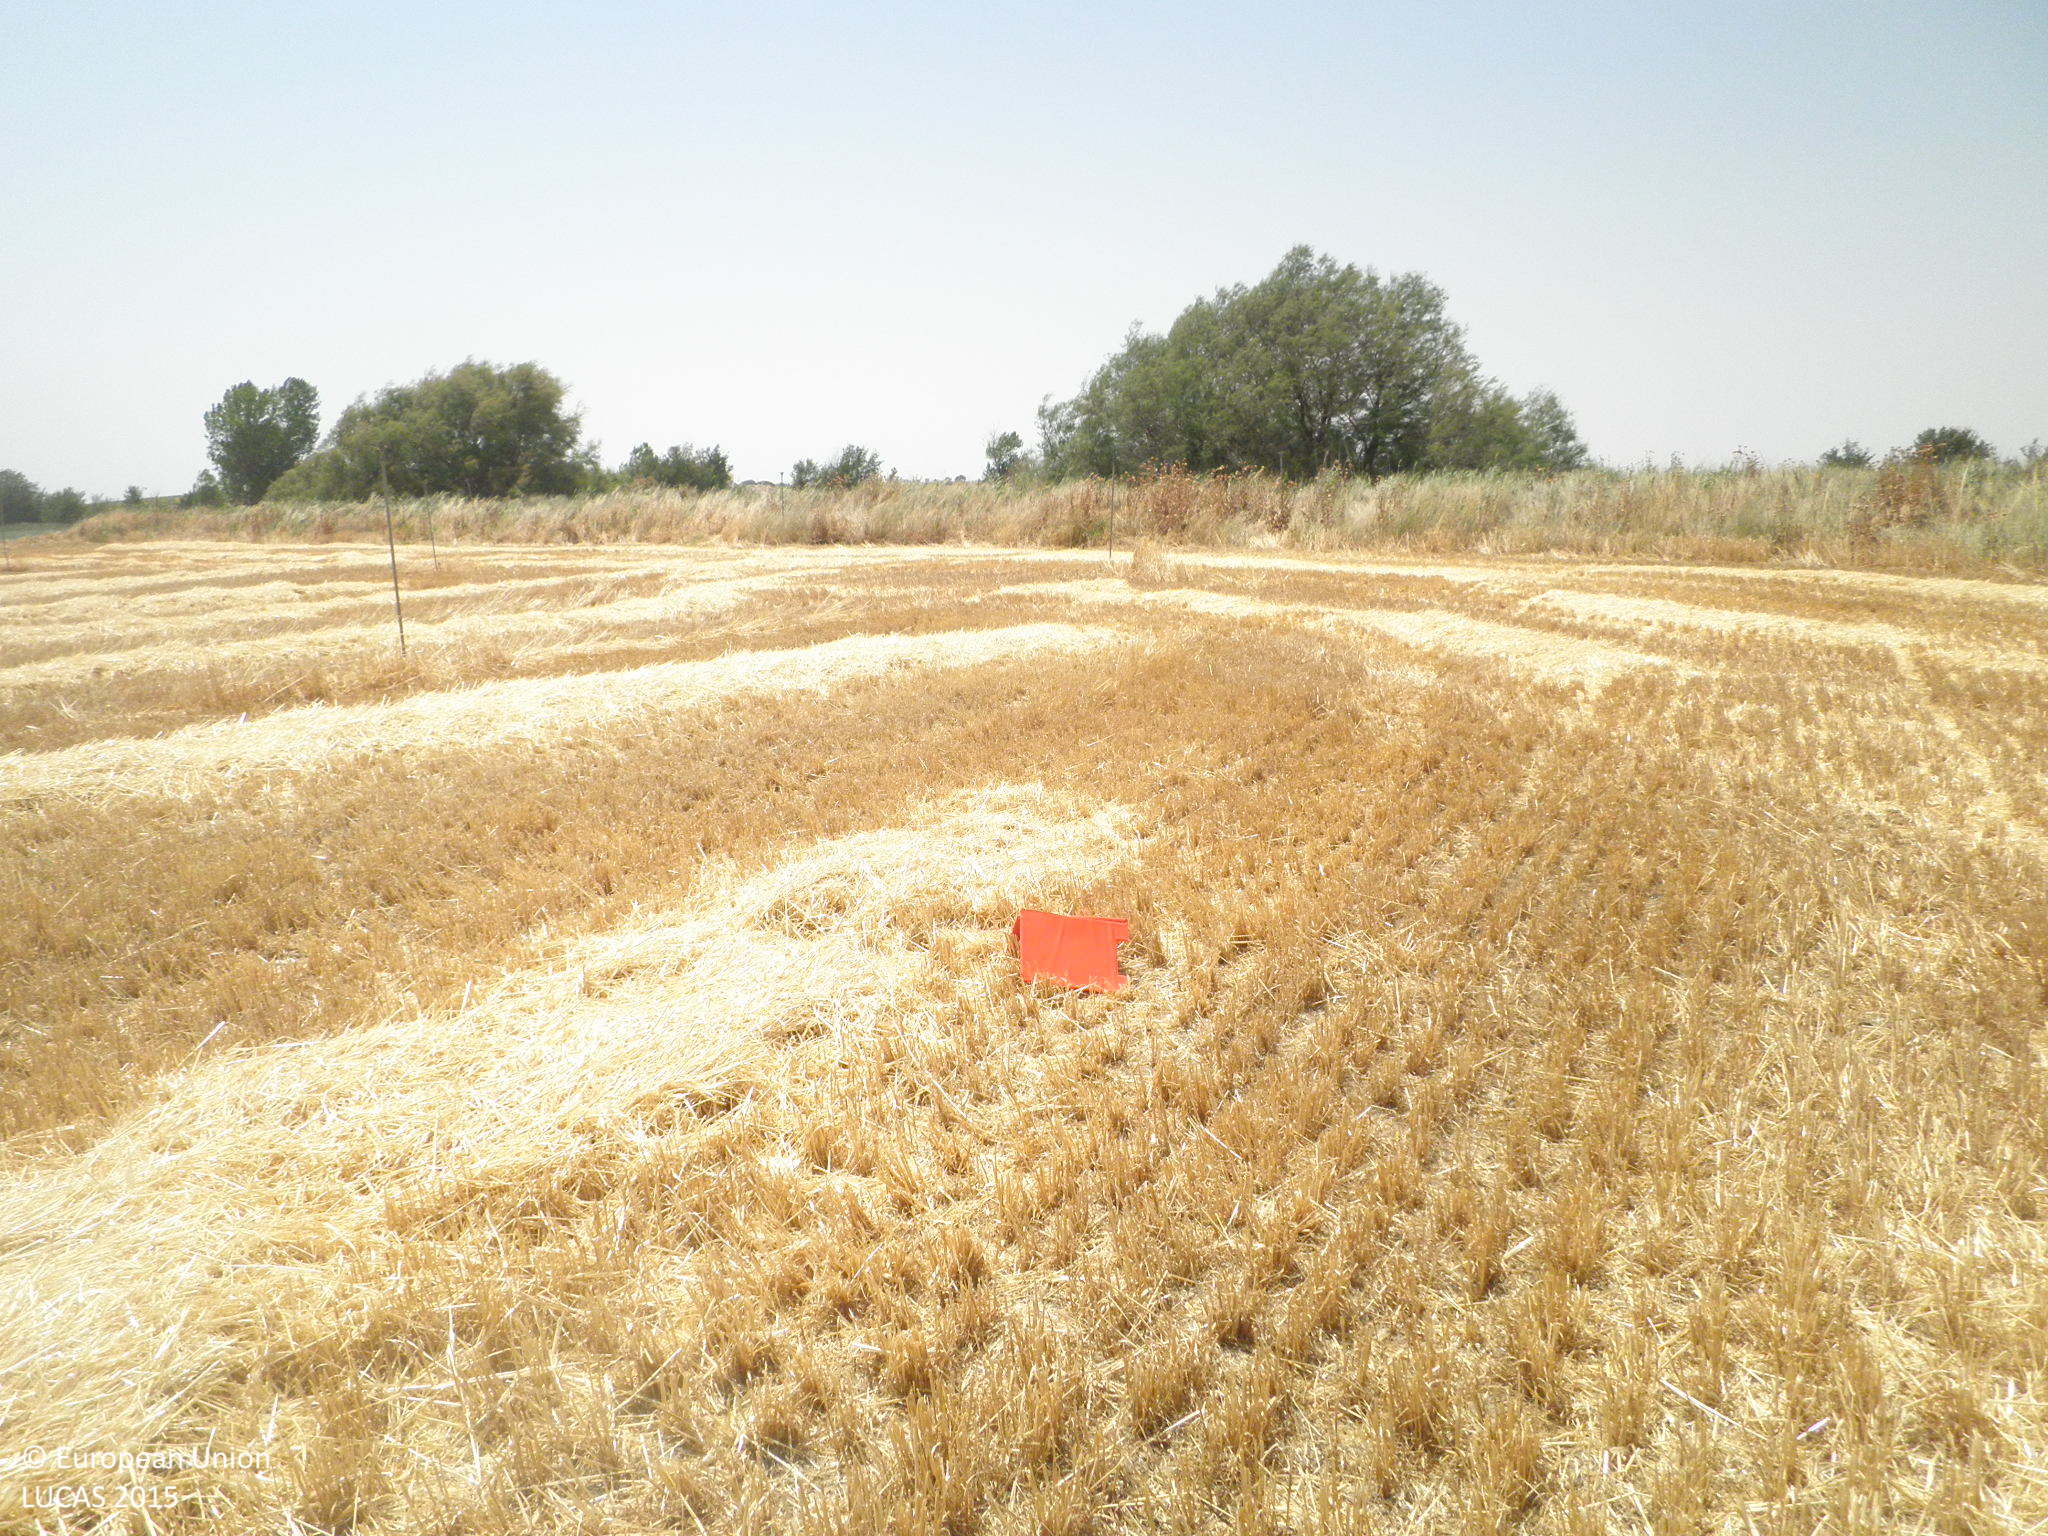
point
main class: Cropland
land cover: Barley
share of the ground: 50 - 75 %
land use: Agriculture (excluding fallow land and kitchen gardens)
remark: Harvested field
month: July
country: ES
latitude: 39.4547
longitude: -2.5750
